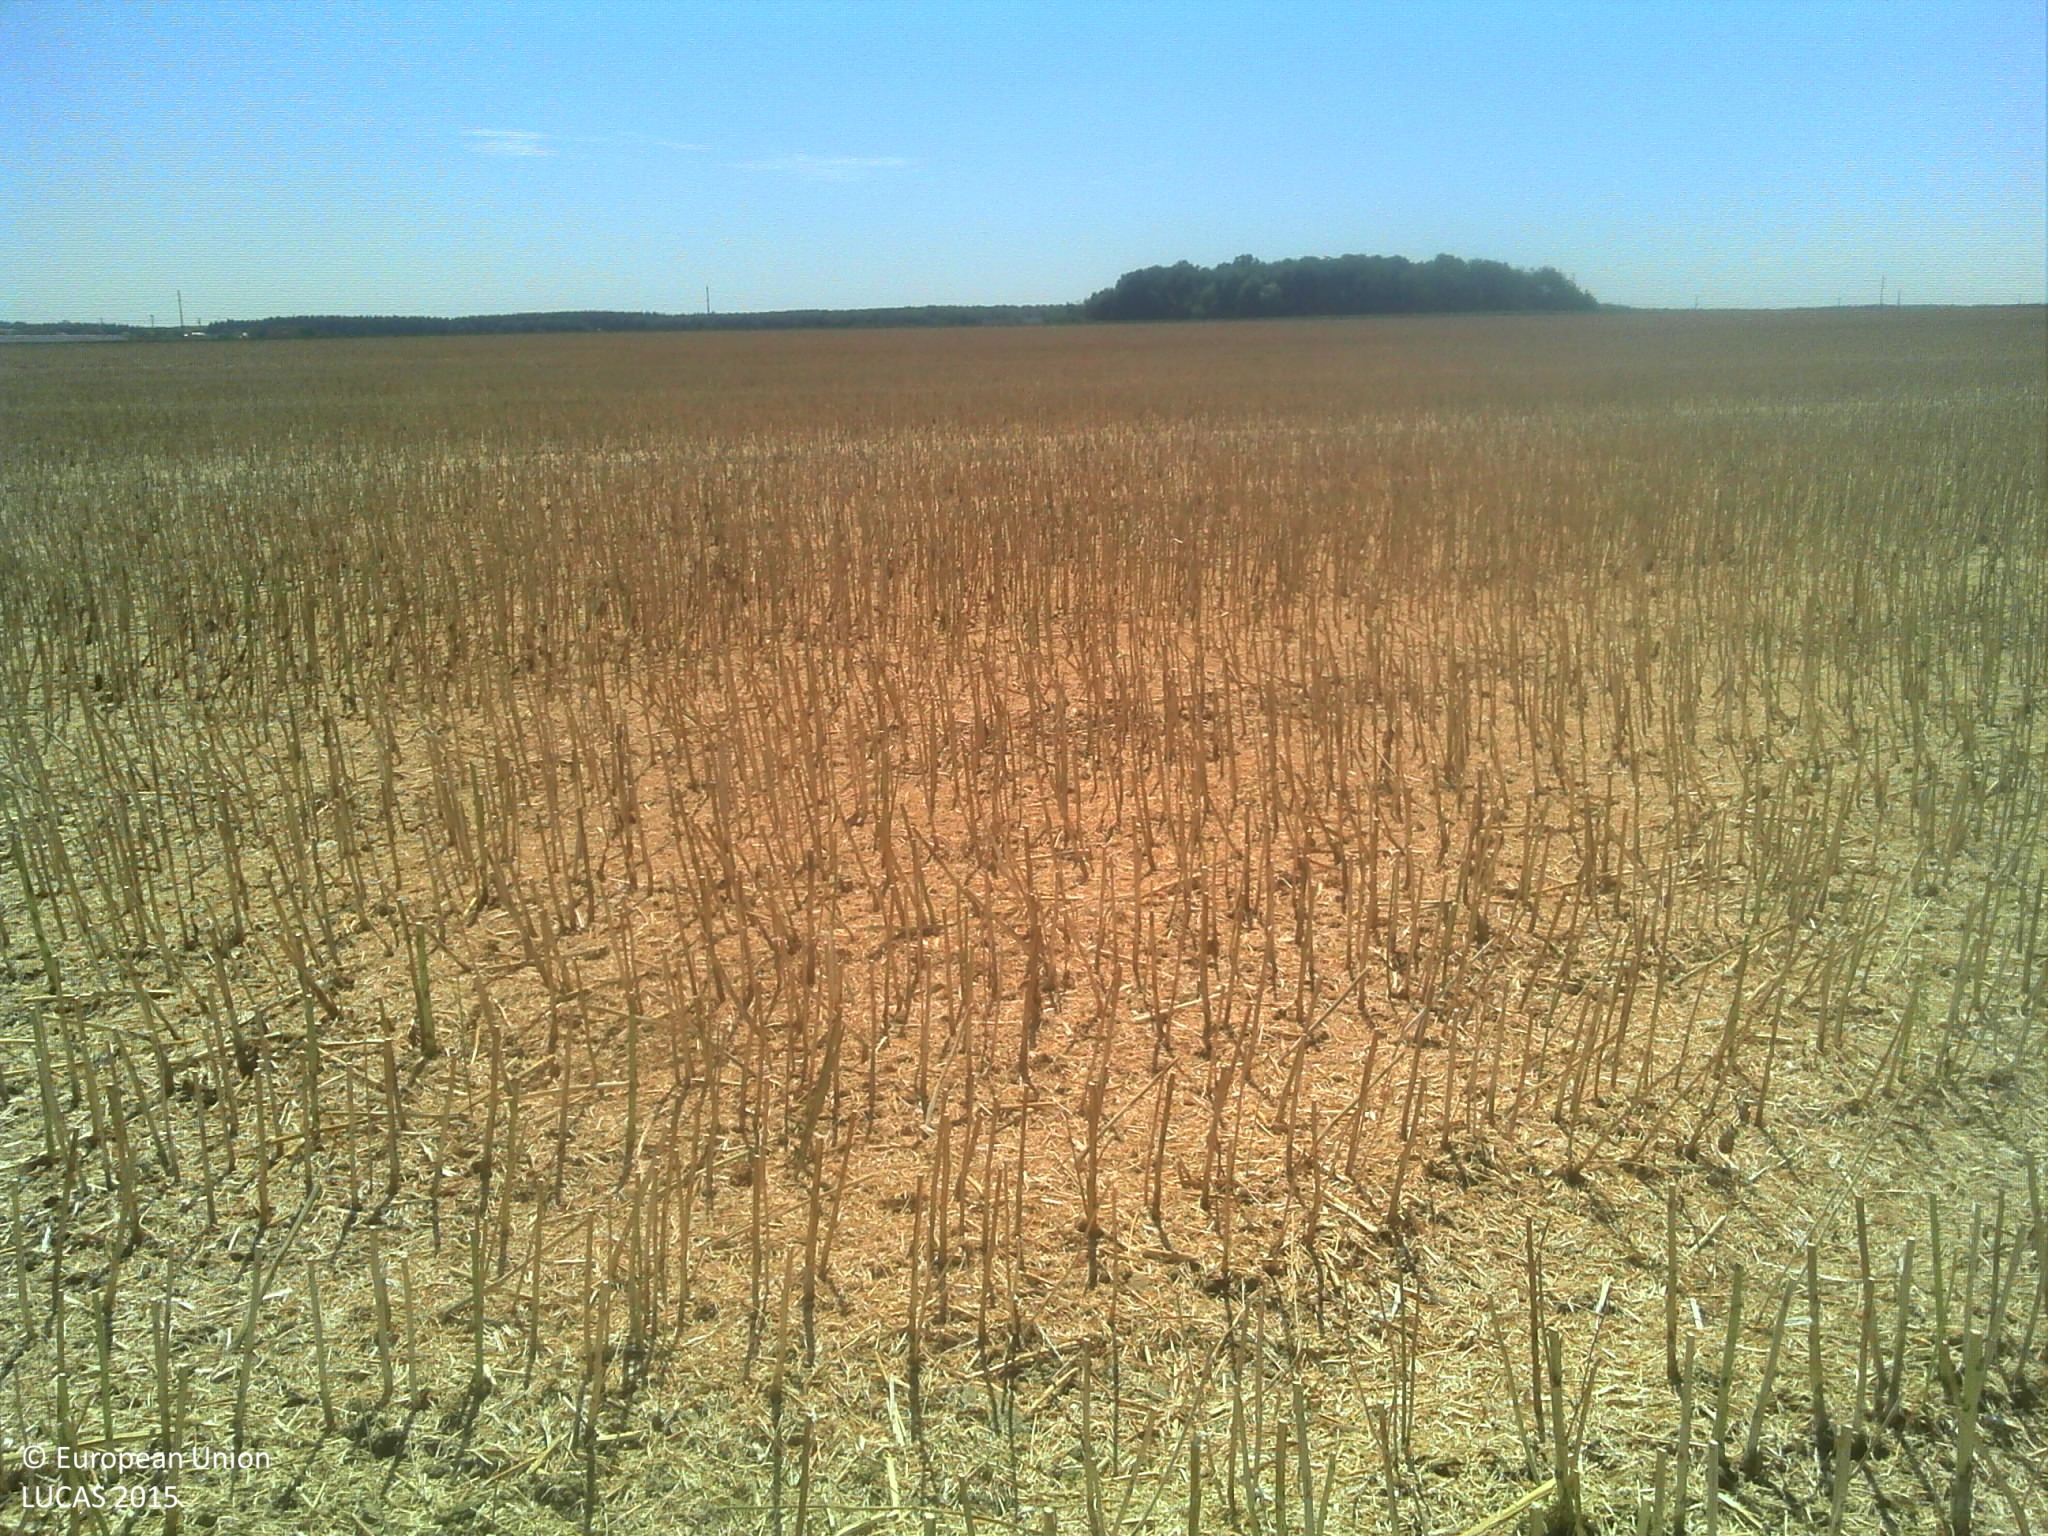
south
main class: Cropland
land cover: Rape and turnip rape
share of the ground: < 10 %
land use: Agriculture (excluding fallow land and kitchen gardens)
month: July
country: FR
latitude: 47.9152
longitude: 1.2993
